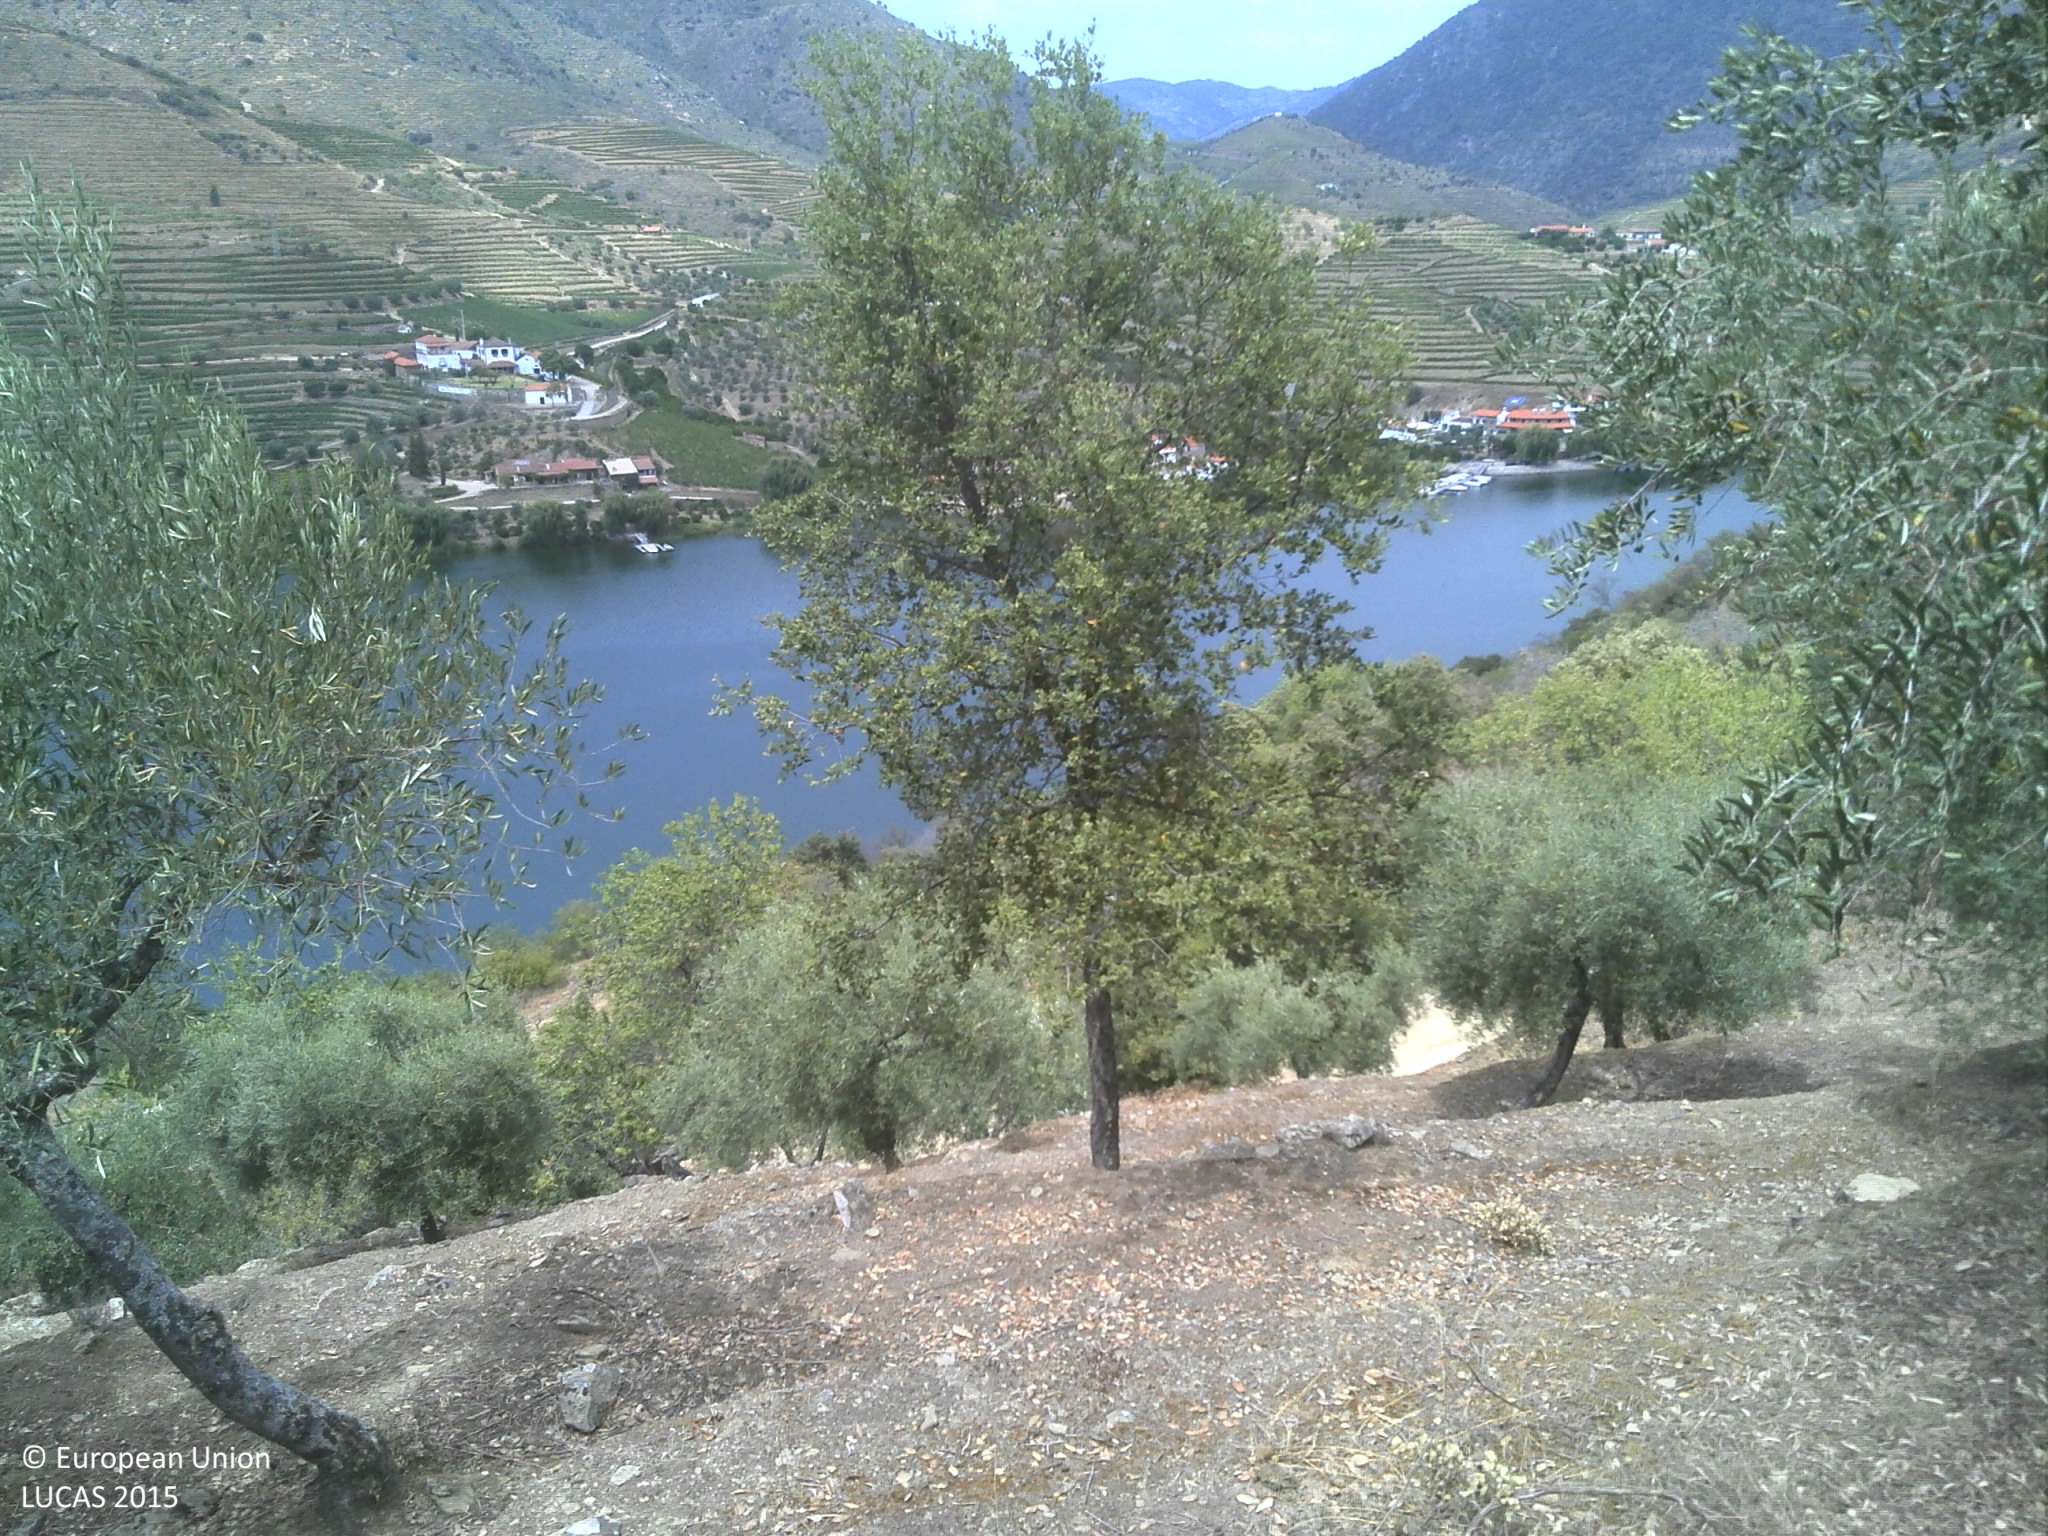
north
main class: Cropland
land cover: Olive groves
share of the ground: 25 - 50 %
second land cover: Other bare soil
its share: > 75 %
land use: Agriculture (excluding fallow land and kitchen gardens)
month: July
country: PT
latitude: 41.1407
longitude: -7.2595
